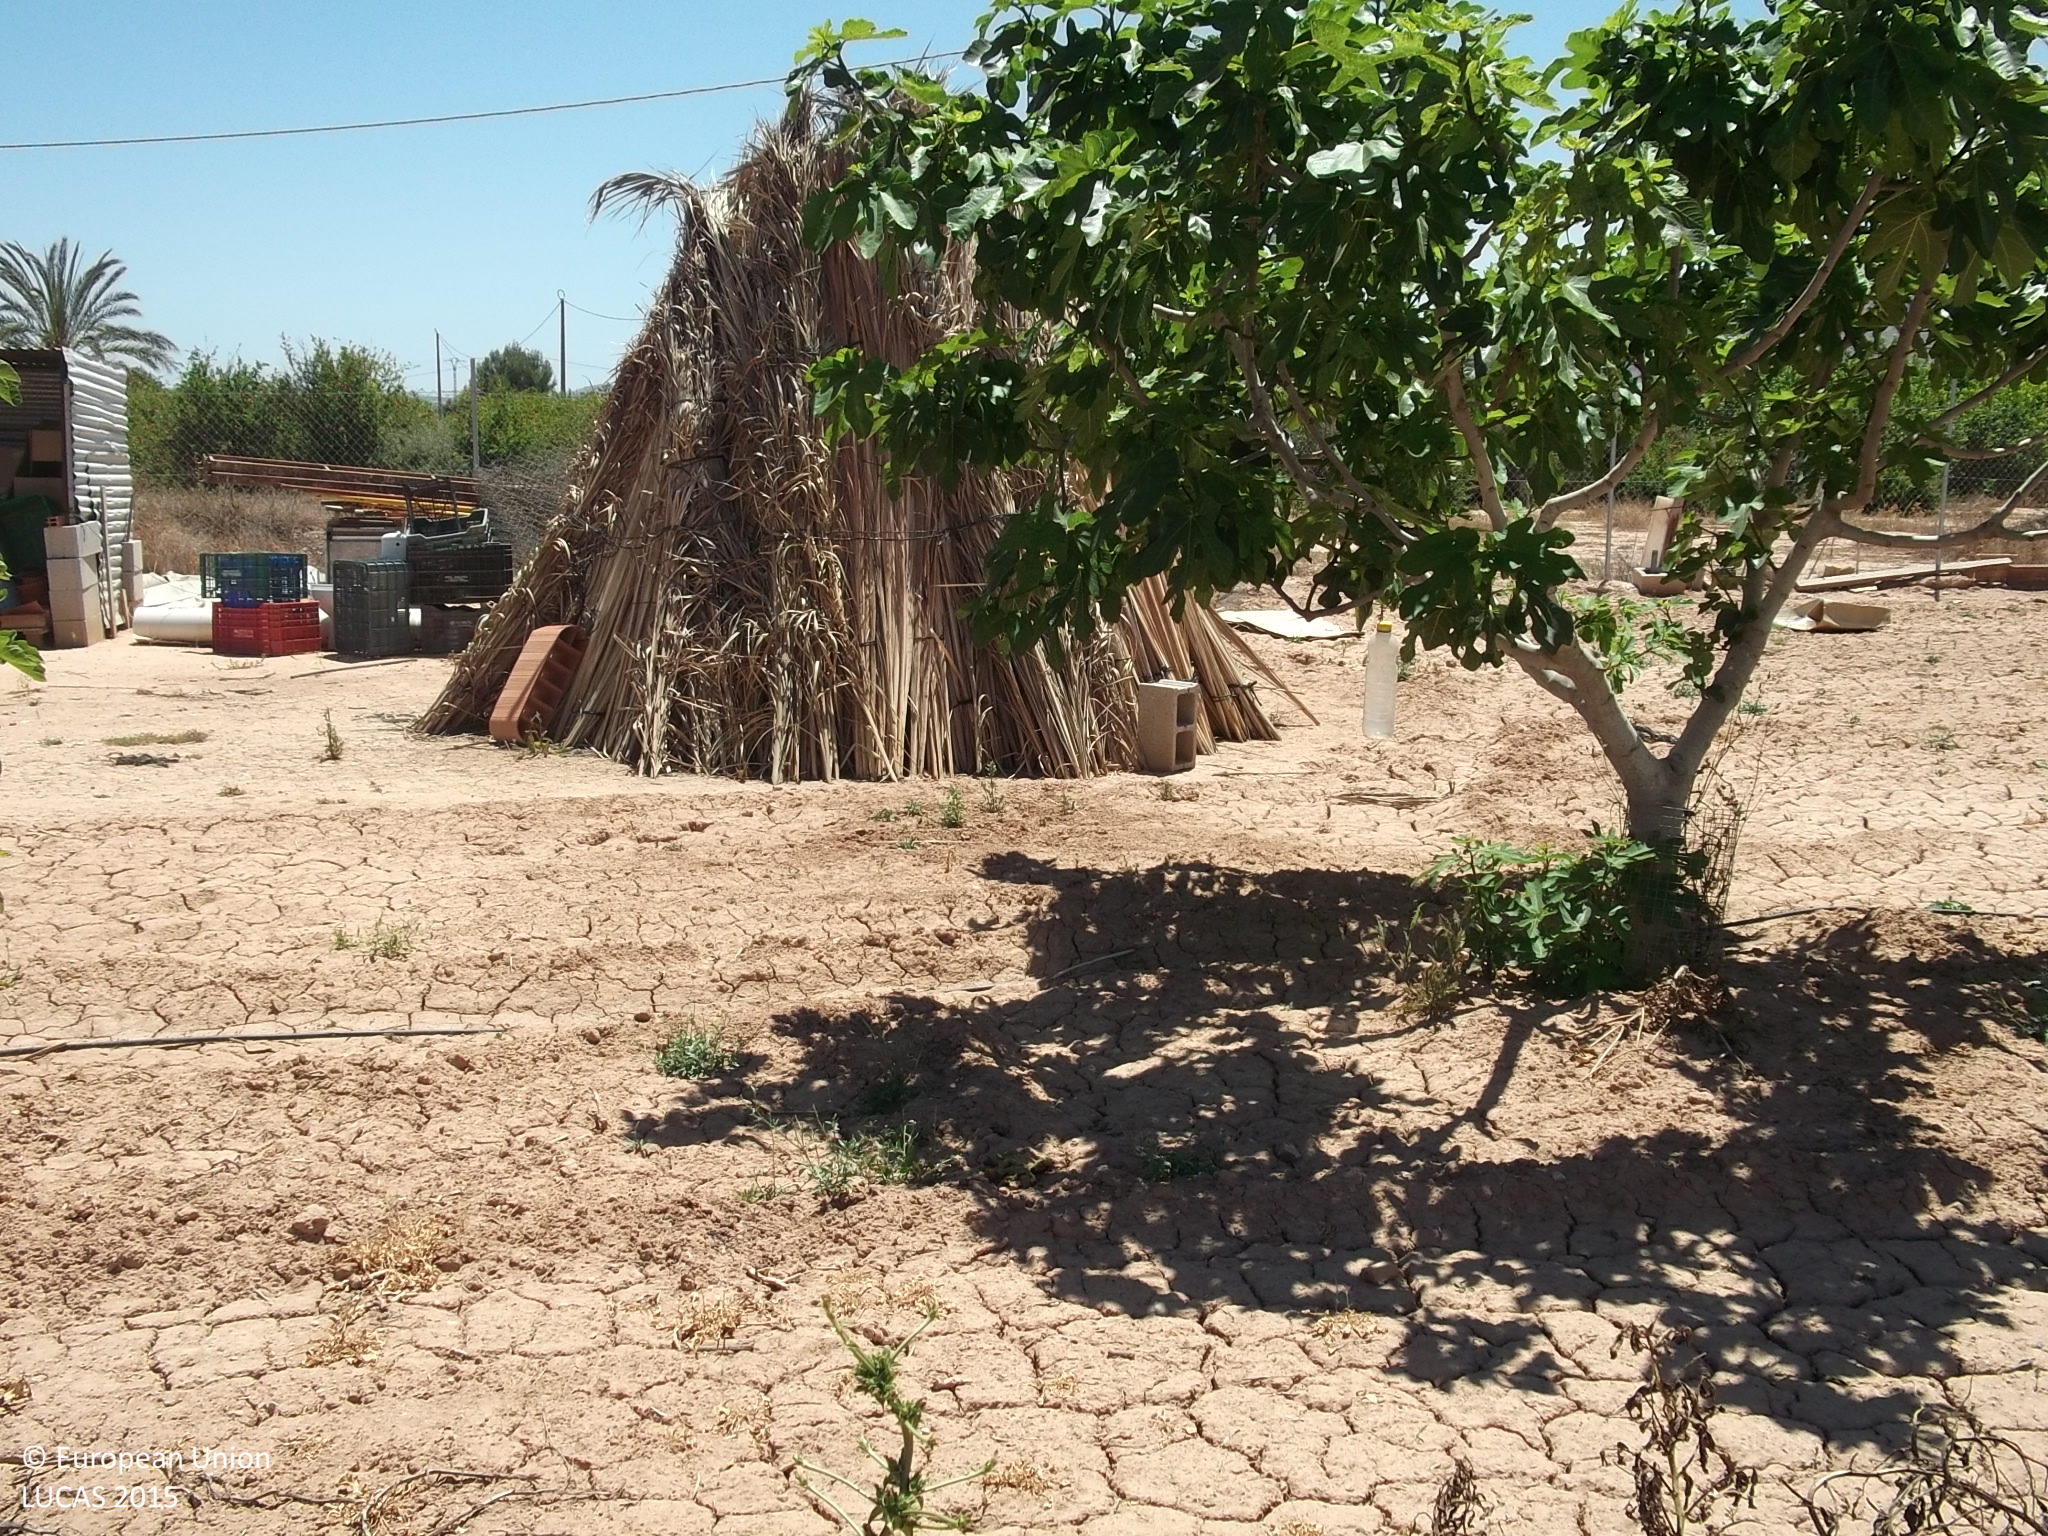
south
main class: Cropland
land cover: Other fruit trees and berries
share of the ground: < 10 %
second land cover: Other bare soil
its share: > 75 %
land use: Agriculture (excluding fallow land and kitchen gardens)
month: May
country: ES
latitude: 38.1807
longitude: -0.8875
